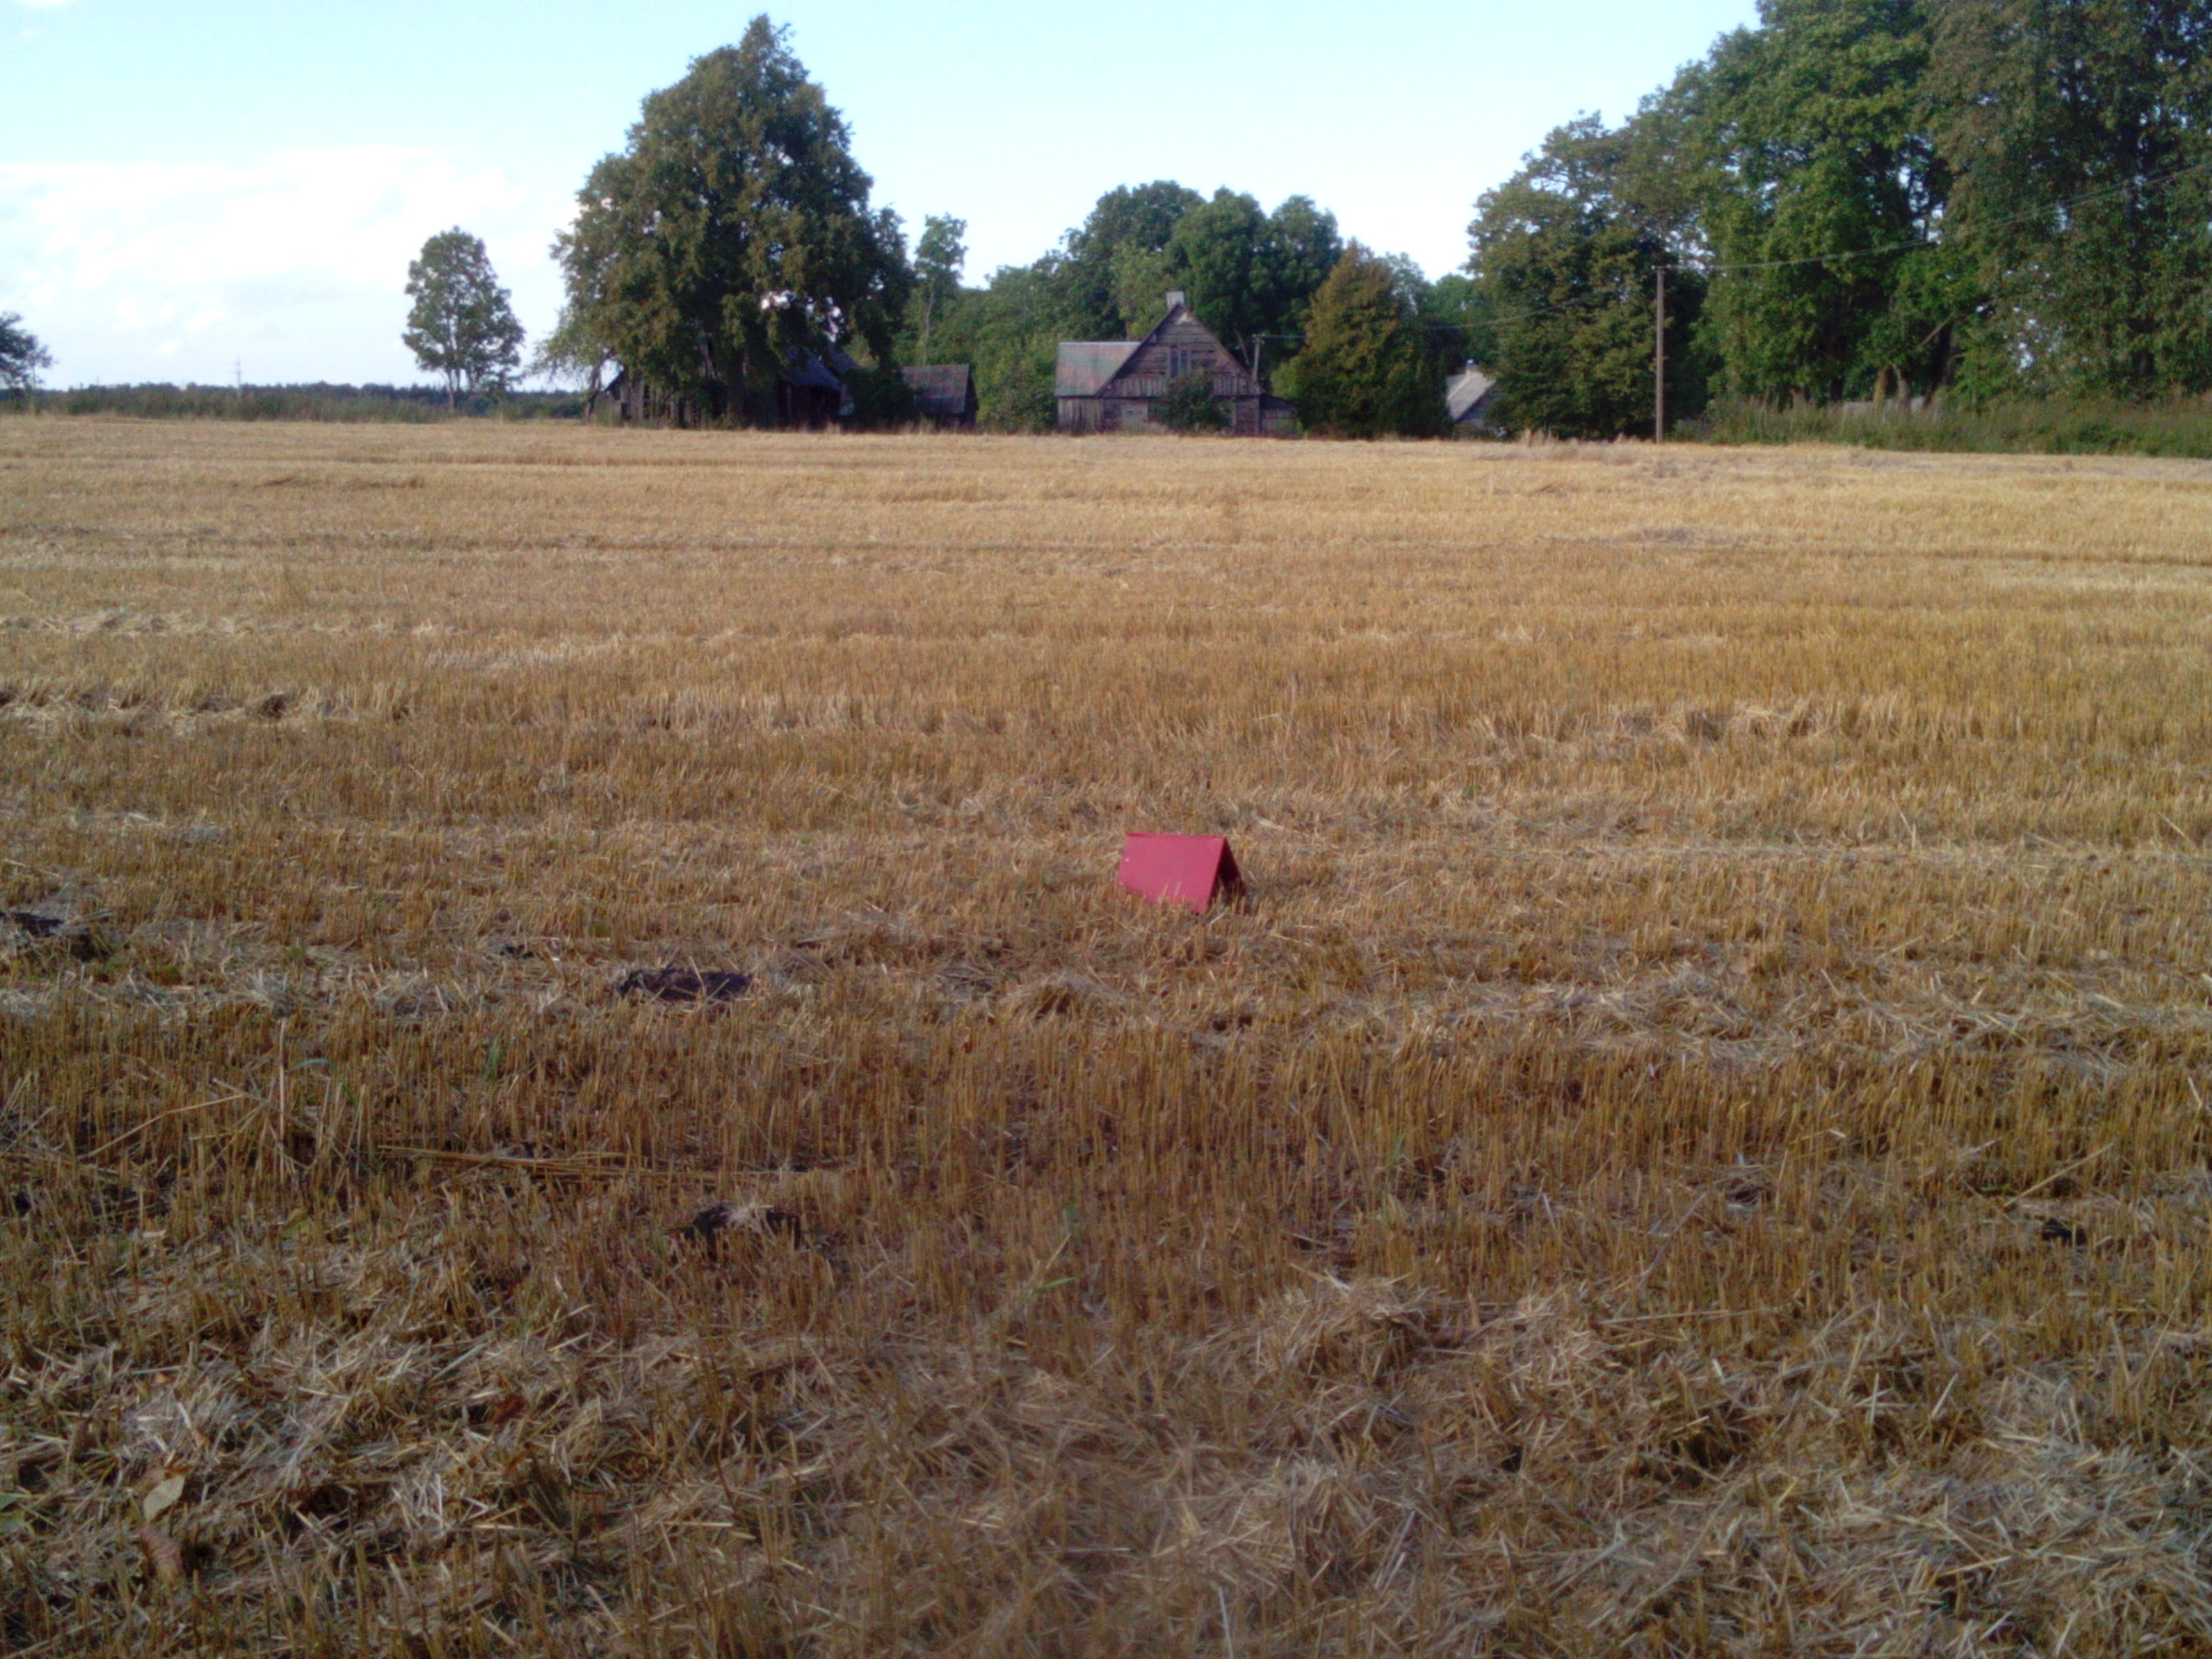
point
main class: Cropland
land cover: Common wheat
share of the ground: > 75 %
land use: Agriculture (excluding fallow land and kitchen gardens)
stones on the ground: < 10 %
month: September
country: LT
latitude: 55.9001
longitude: 22.8768
